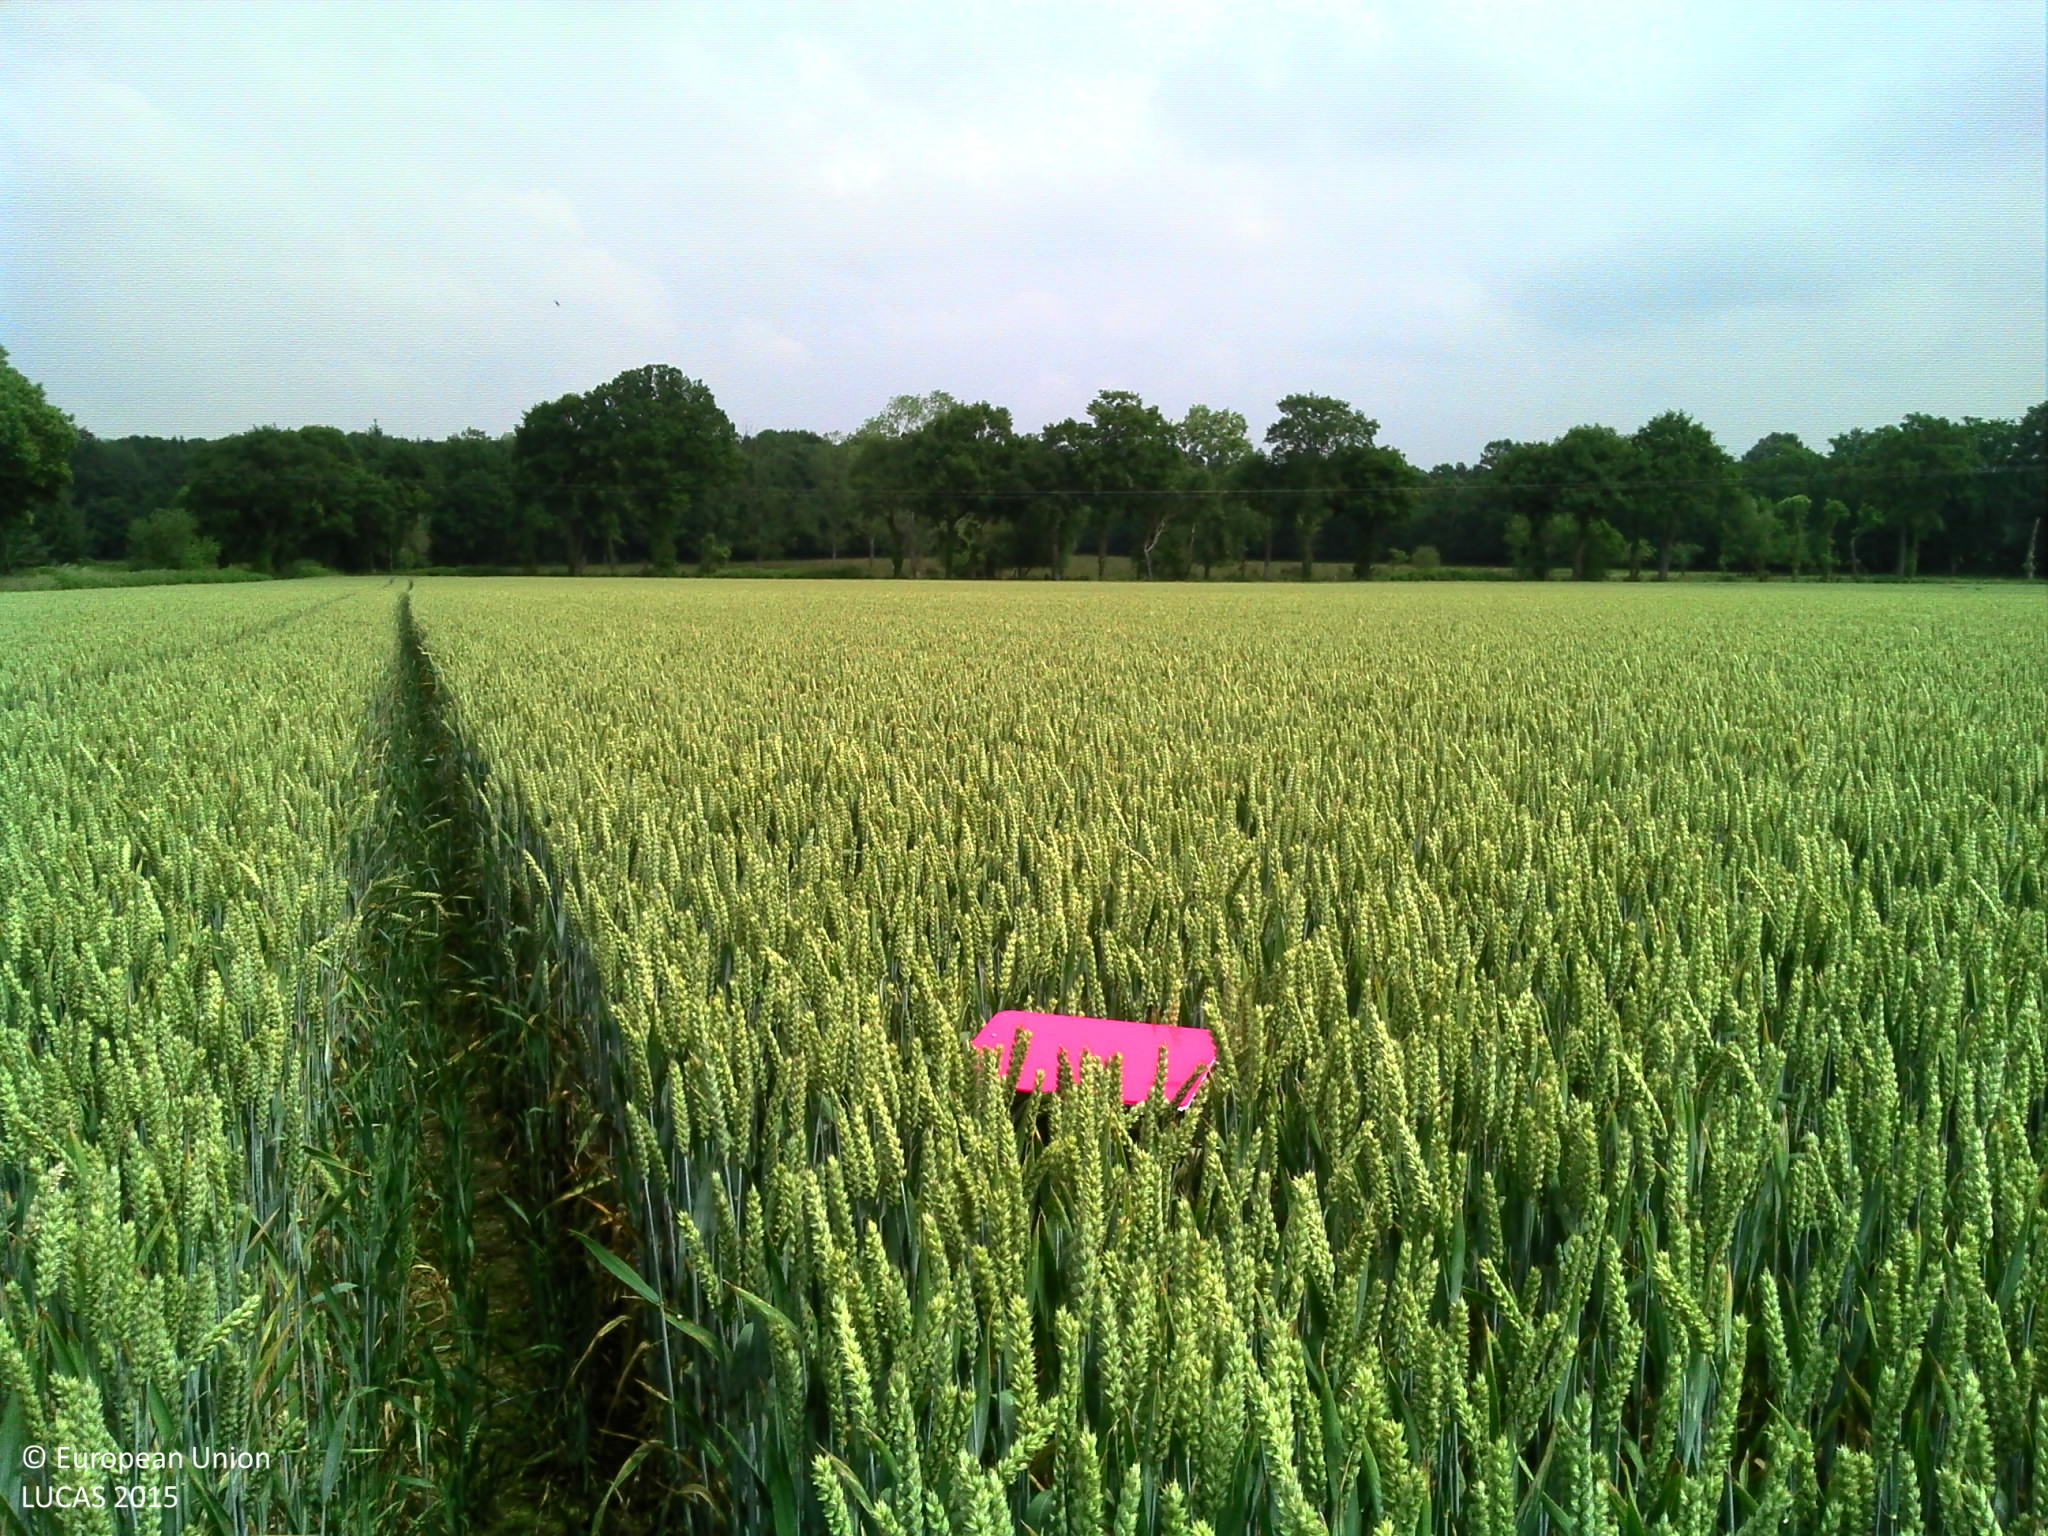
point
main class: Cropland
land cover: Common wheat
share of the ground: > 75 %
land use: Agriculture (excluding fallow land and kitchen gardens)
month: June
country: FR
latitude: 48.5215
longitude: -1.7349
